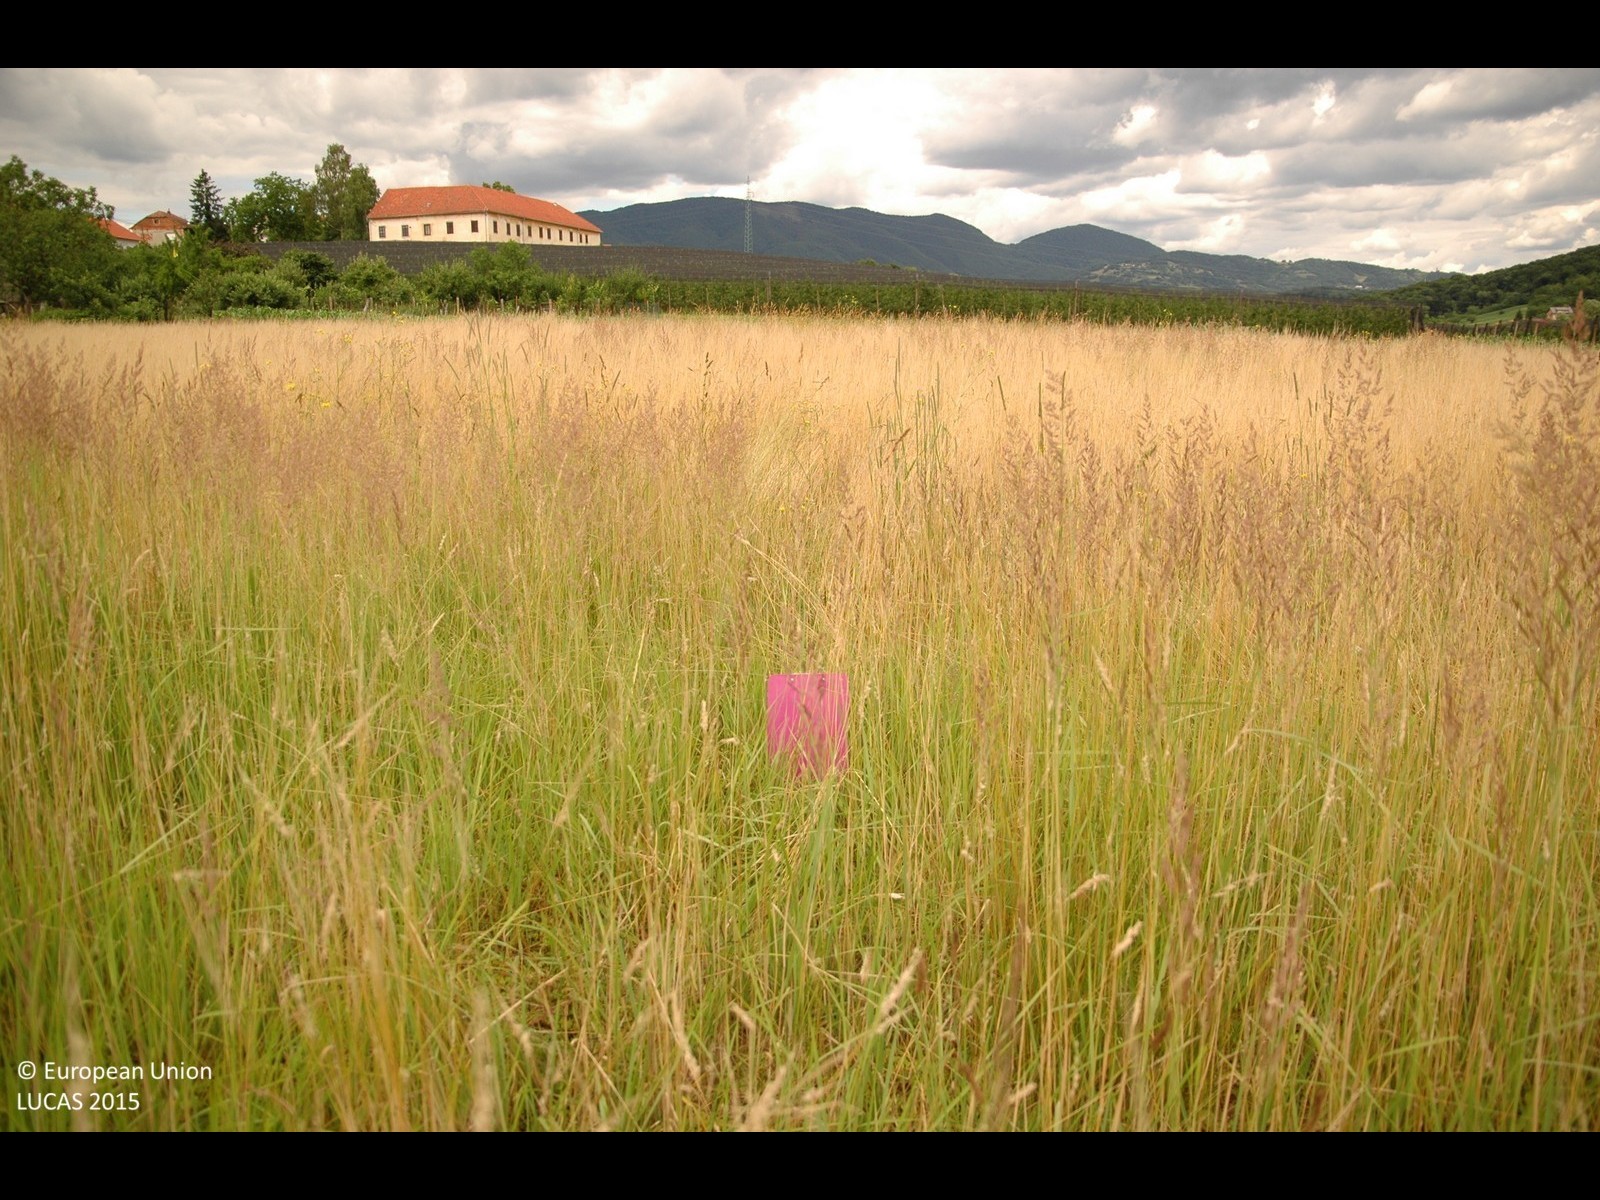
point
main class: Grassland
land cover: Grassland without tree/shrub cover
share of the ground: > 75 %
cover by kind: herbaceous plants 100 %
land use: Agriculture (excluding fallow land and kitchen gardens)
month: June
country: HR
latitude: 46.1348
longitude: 15.8880
